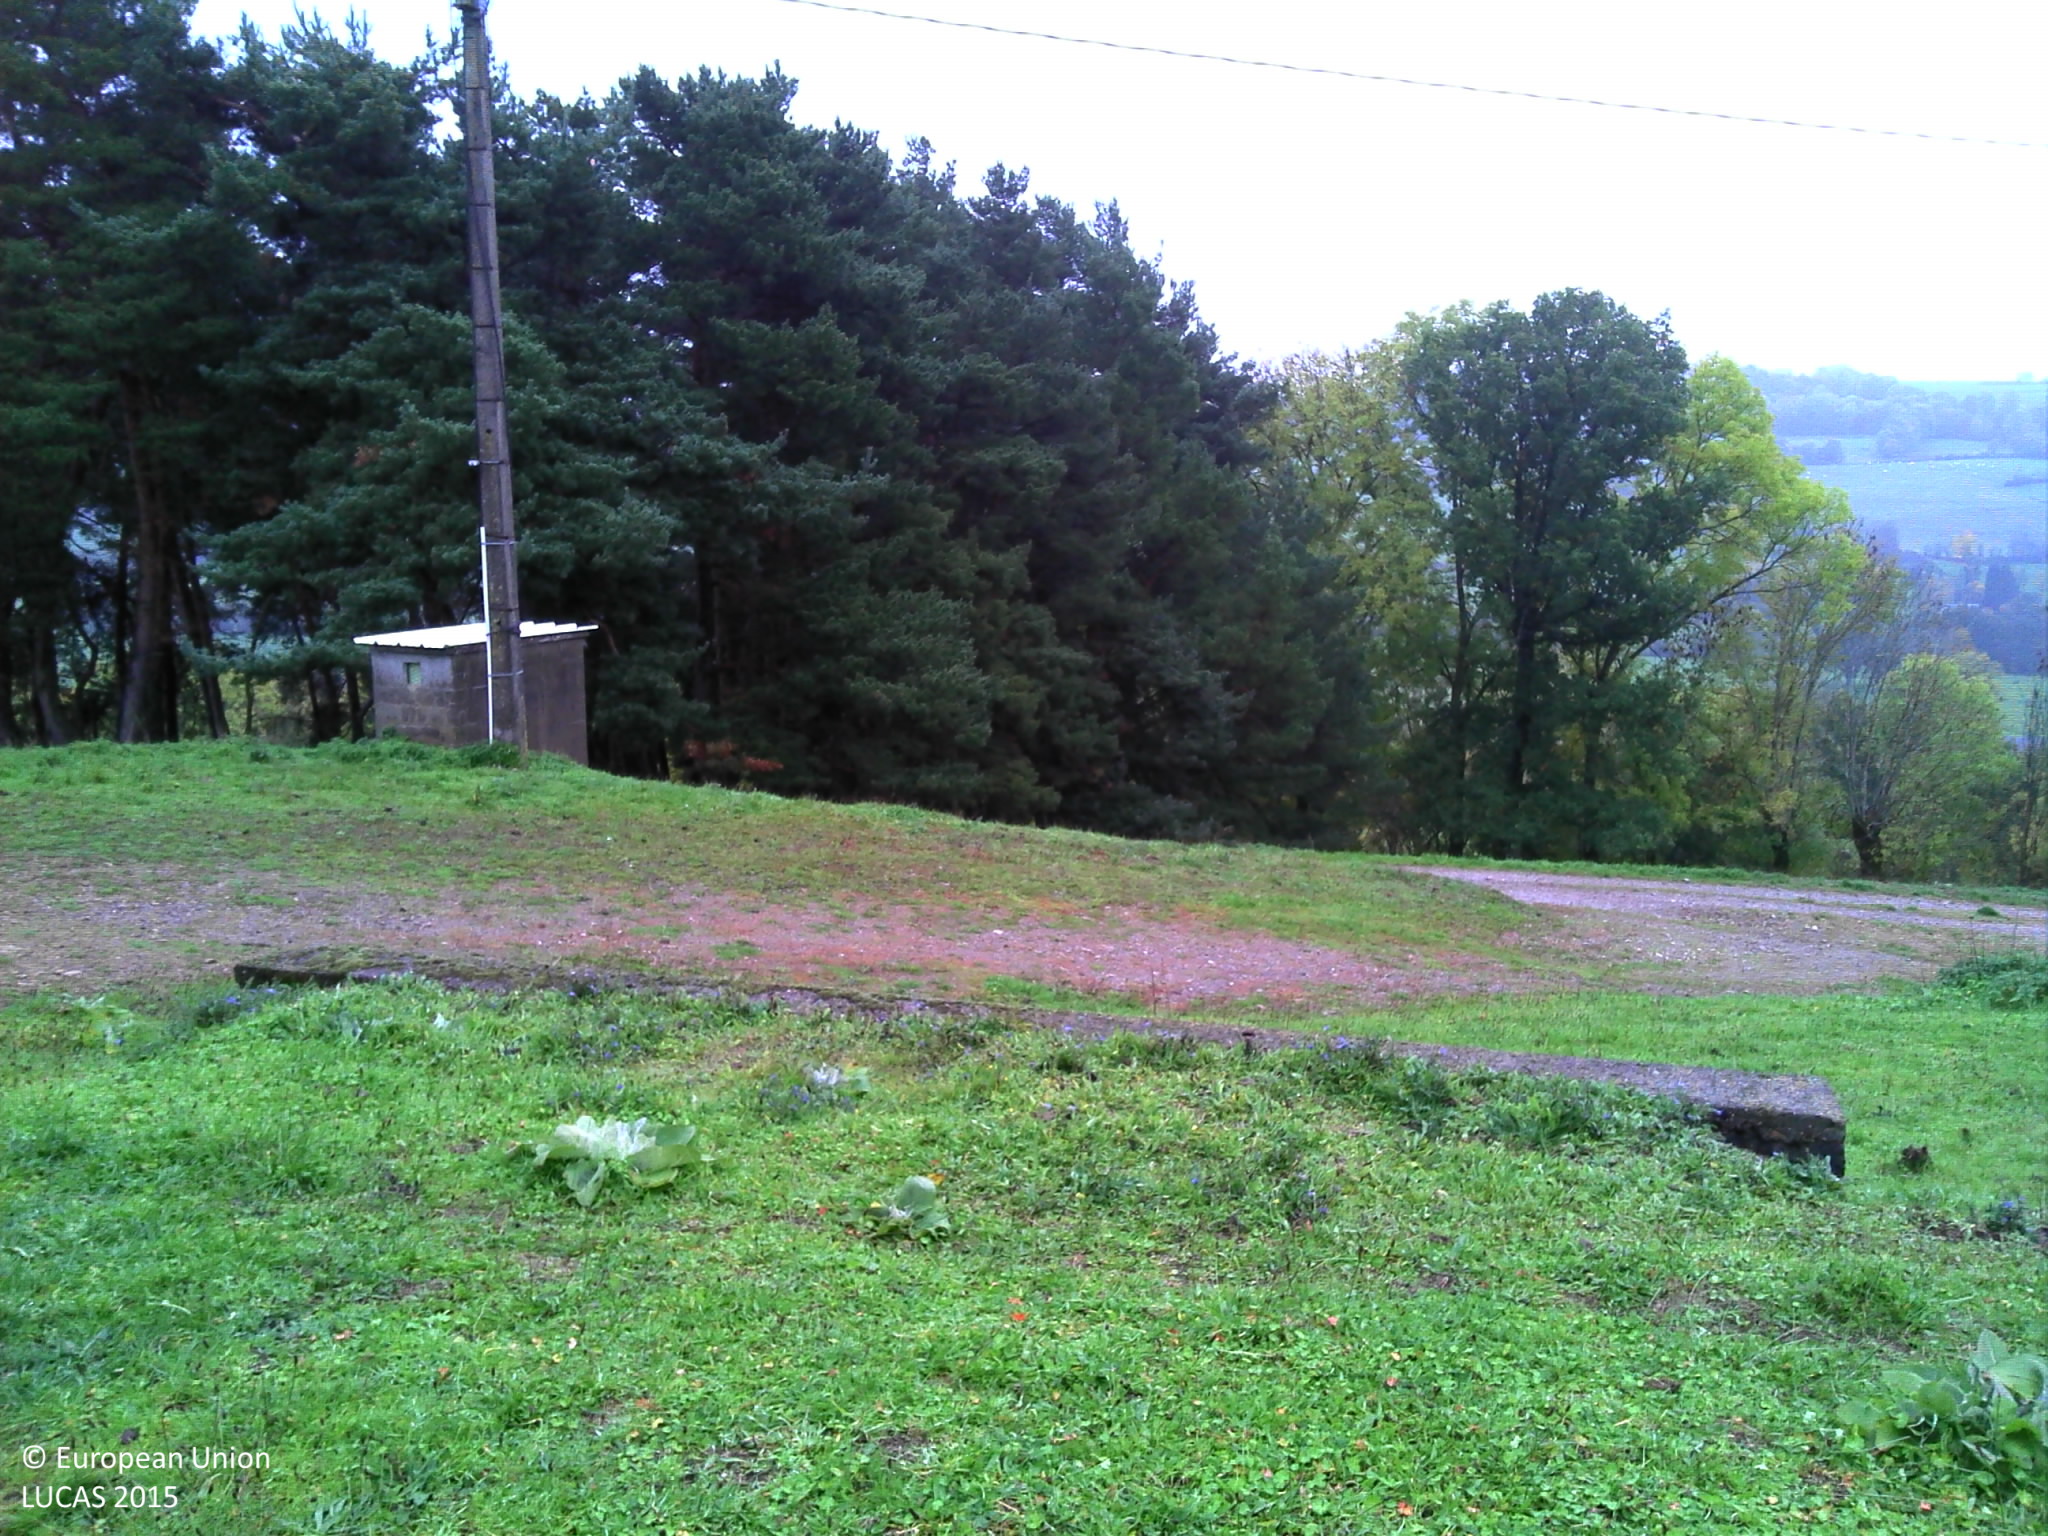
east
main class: Grassland
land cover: Grassland without tree/shrub cover
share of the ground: > 75 %
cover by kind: herbaceous plants 85 %, unconsolidated bare surface 15 %
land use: Agriculture (excluding fallow land and kitchen gardens)
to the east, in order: Grassland without tree/shrub cover; Dry stone walls; Tracks; Grassland without tree/shrub cover; Electric lines; Grassland without tree/shrub cover; Tracks; Pine dominated coniferous woodland; Fences; Grassland without tree/shrub cover; Fences; Broadleaved woodland; Tracks; Broadleaved woodland; Spontaneously vegetated surfaces; Ditches and canals; Grass margins; Paved roads, cycling and walking lanes; Grass margins; Fences; Temporary grasslands; Broadleaved woodland
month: October
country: FR
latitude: 45.7477
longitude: 2.8134
